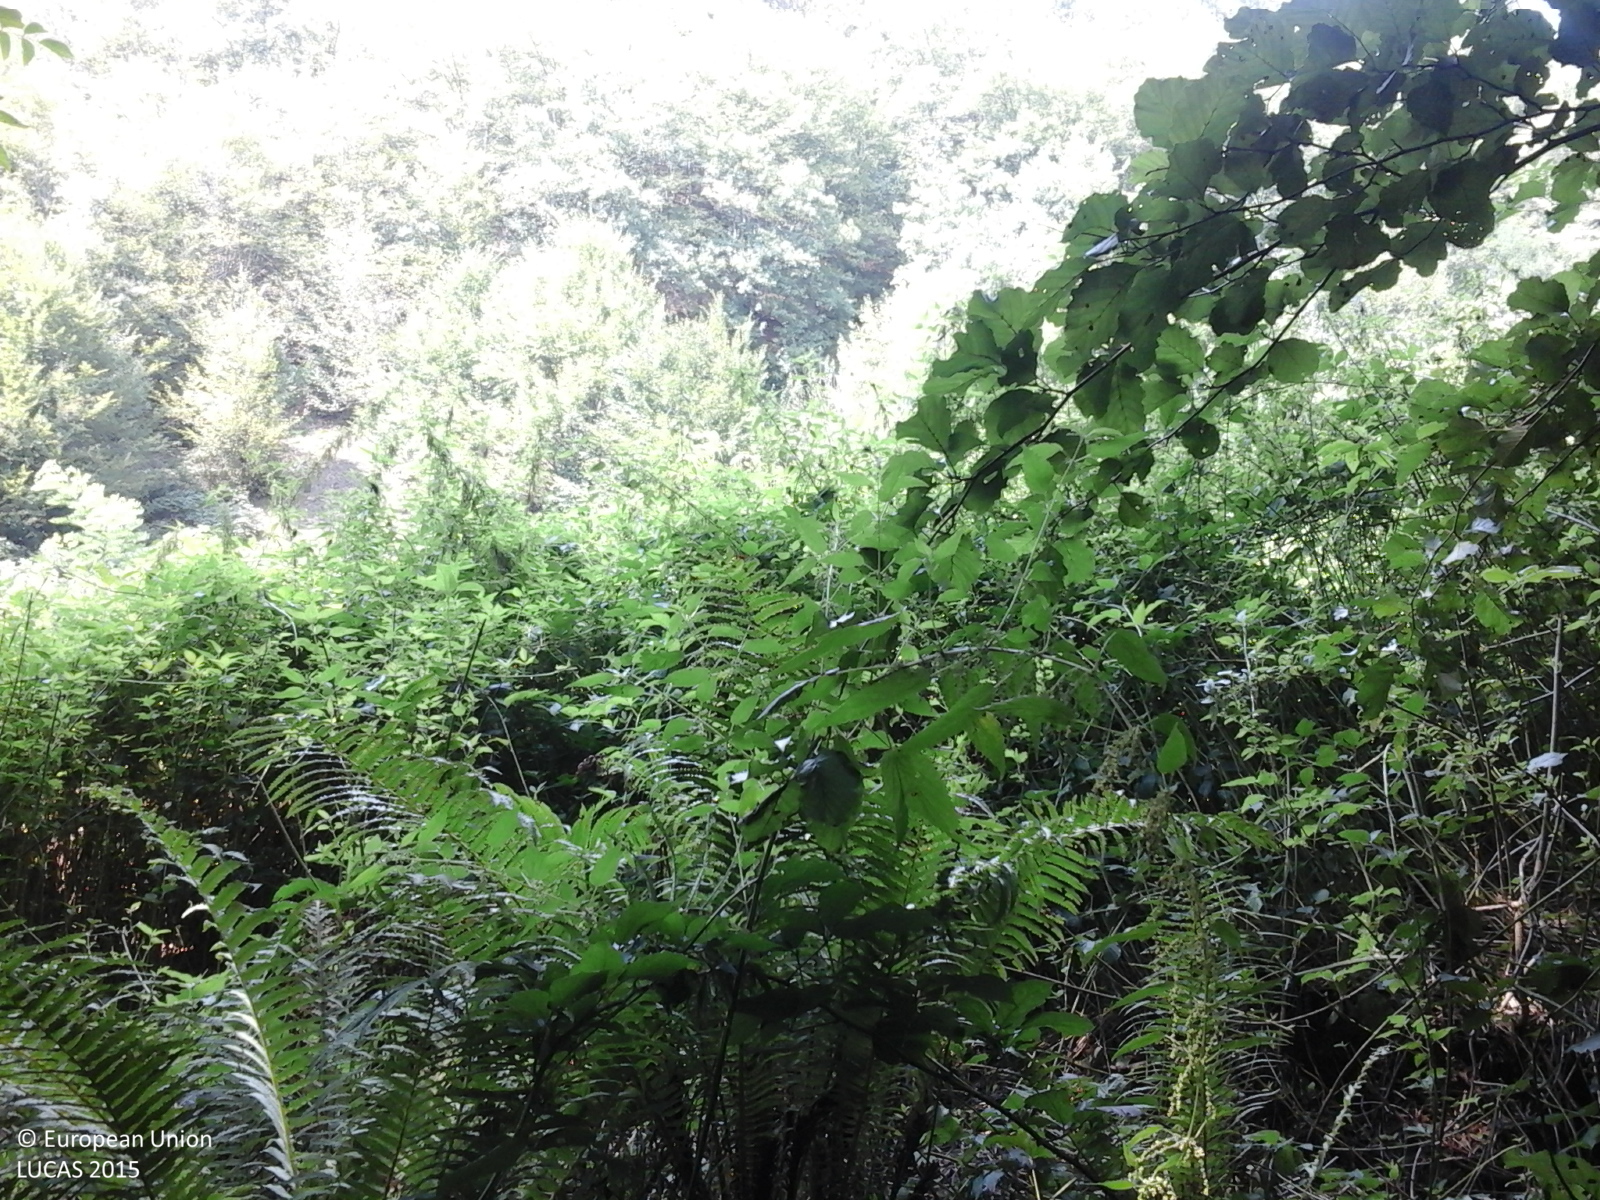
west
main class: Woodland
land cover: Broadleaved woodland
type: broadleaved evergreen forest
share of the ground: > 75 %
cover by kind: broadleaved forest trees 100 %
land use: Forestry
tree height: > 5 m
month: August
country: RO
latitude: 46.2919
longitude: 22.4725
